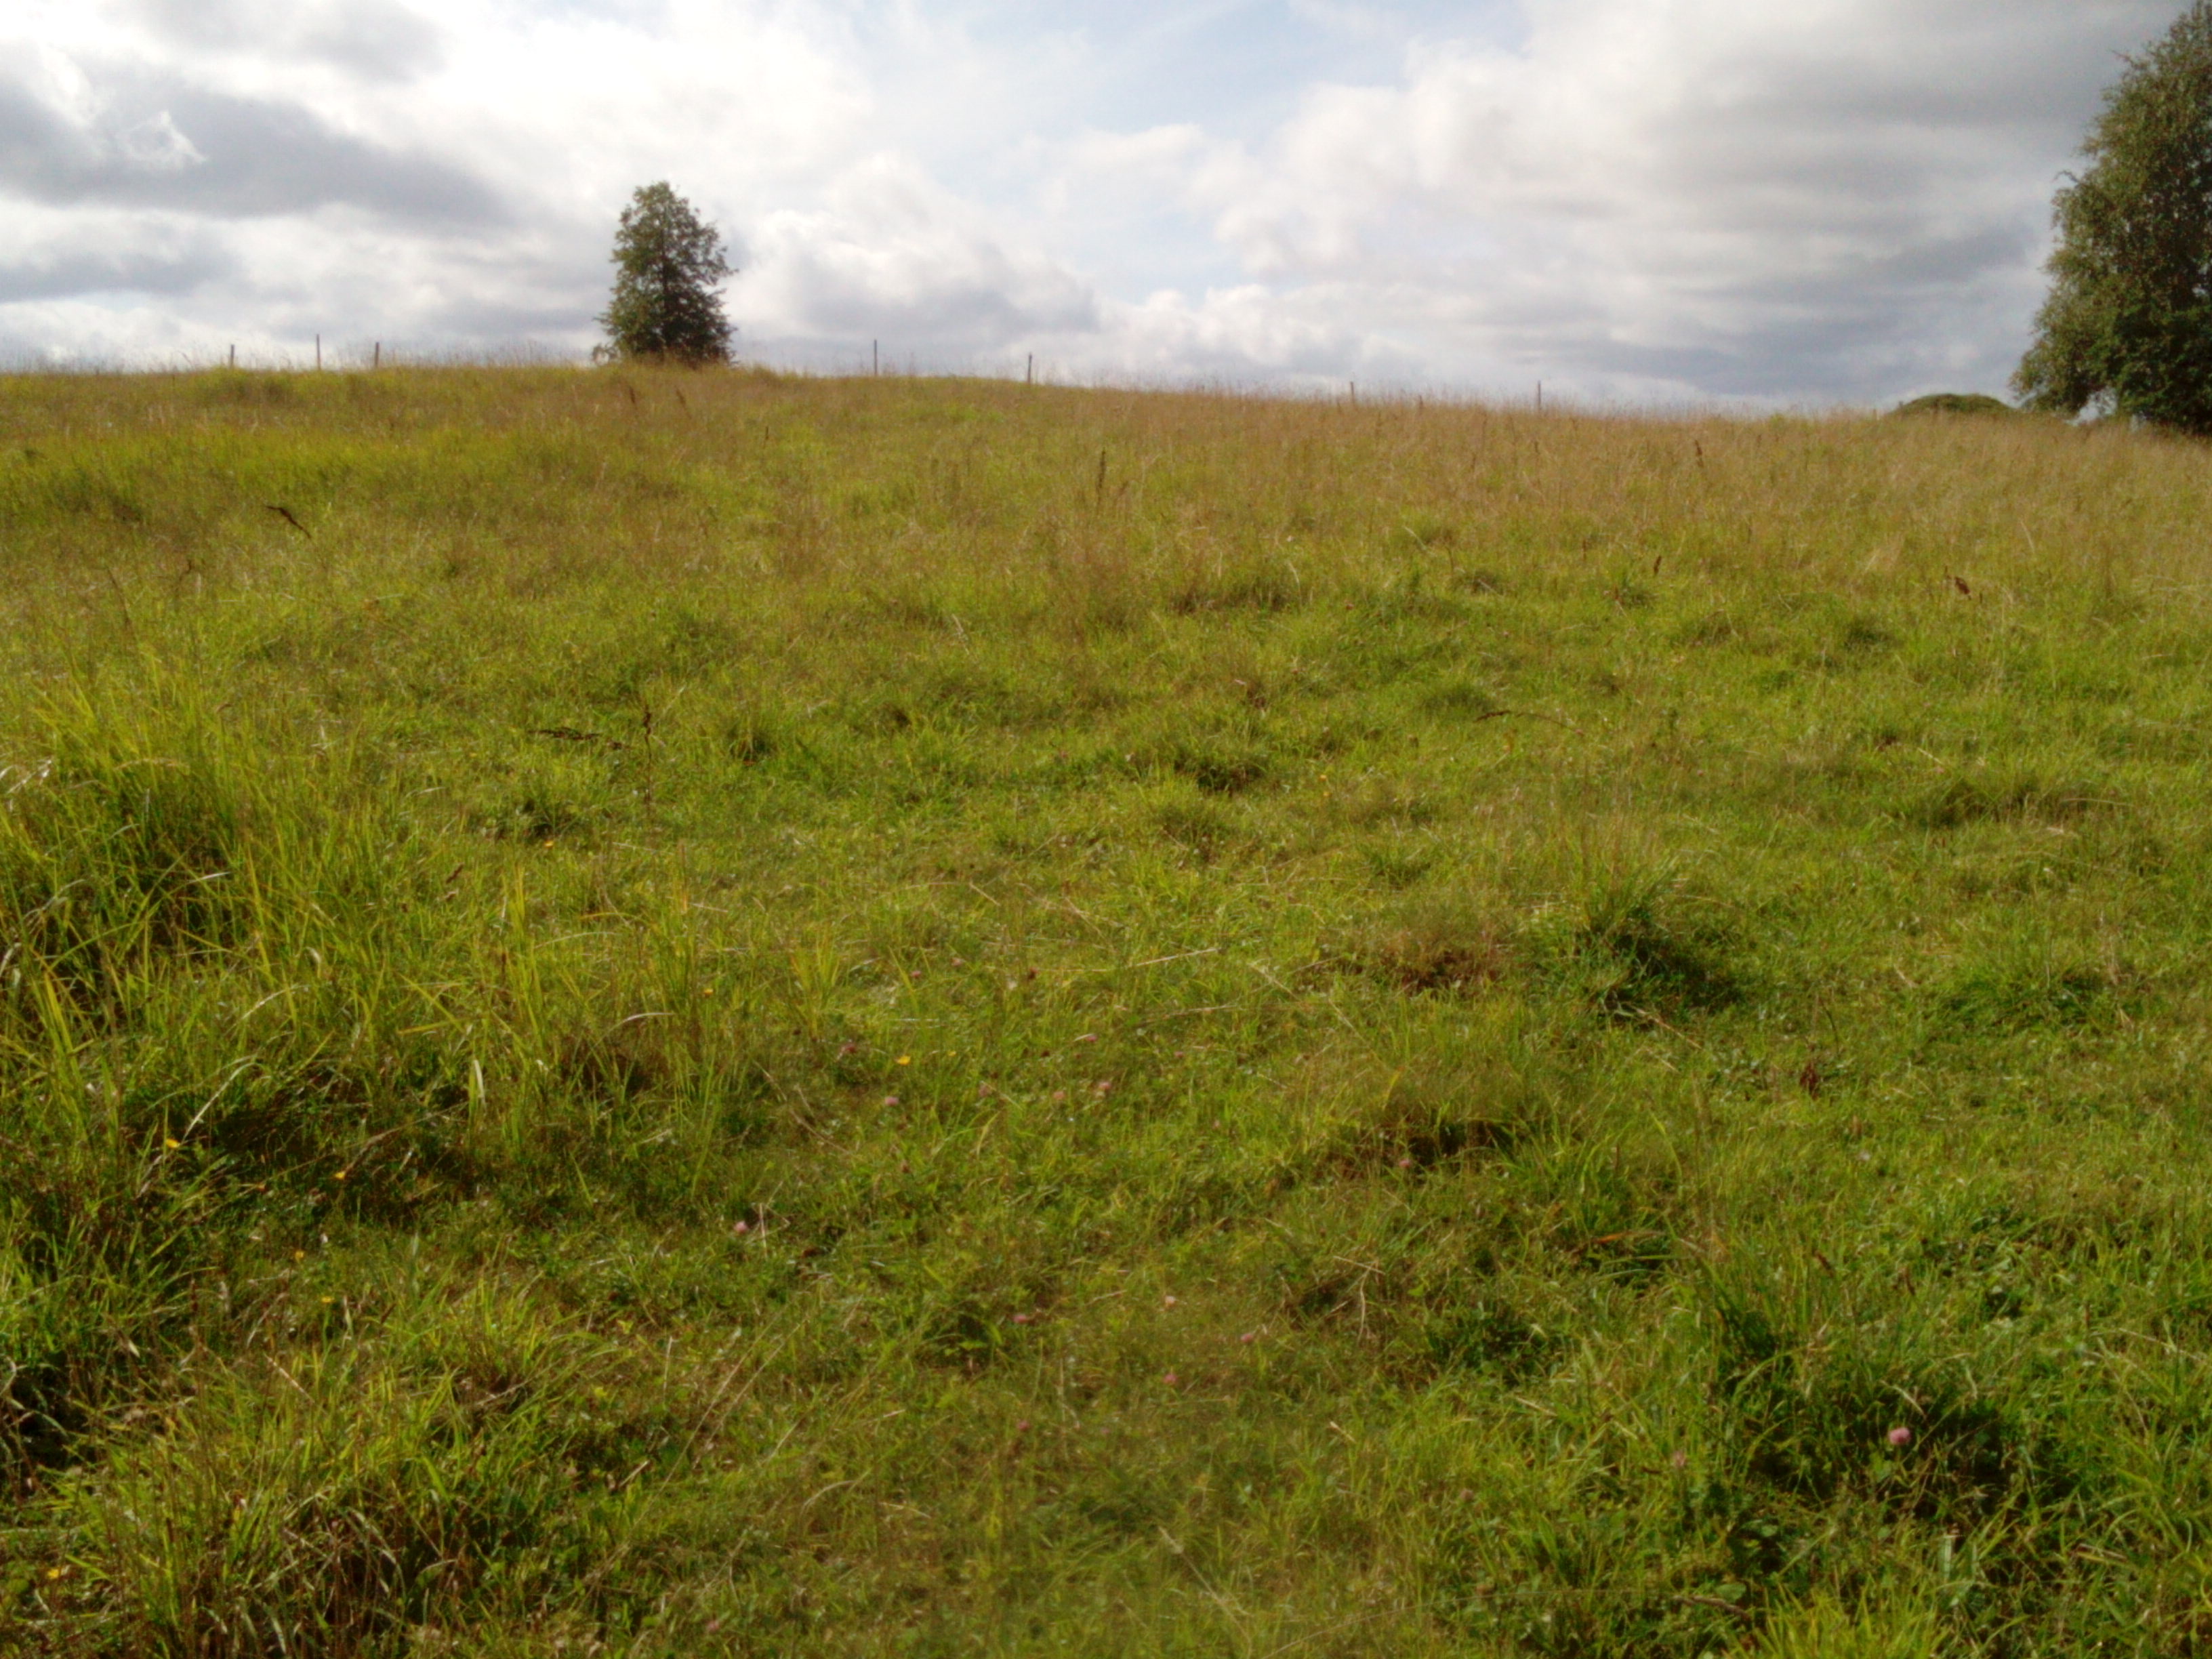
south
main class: Grassland
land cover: Grassland without tree/shrub cover
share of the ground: > 75 %
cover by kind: herbaceous plants 100 %
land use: Agriculture (excluding fallow land and kitchen gardens)
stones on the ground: < 10 %
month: September
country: LT
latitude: 55.9242
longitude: 22.8196
